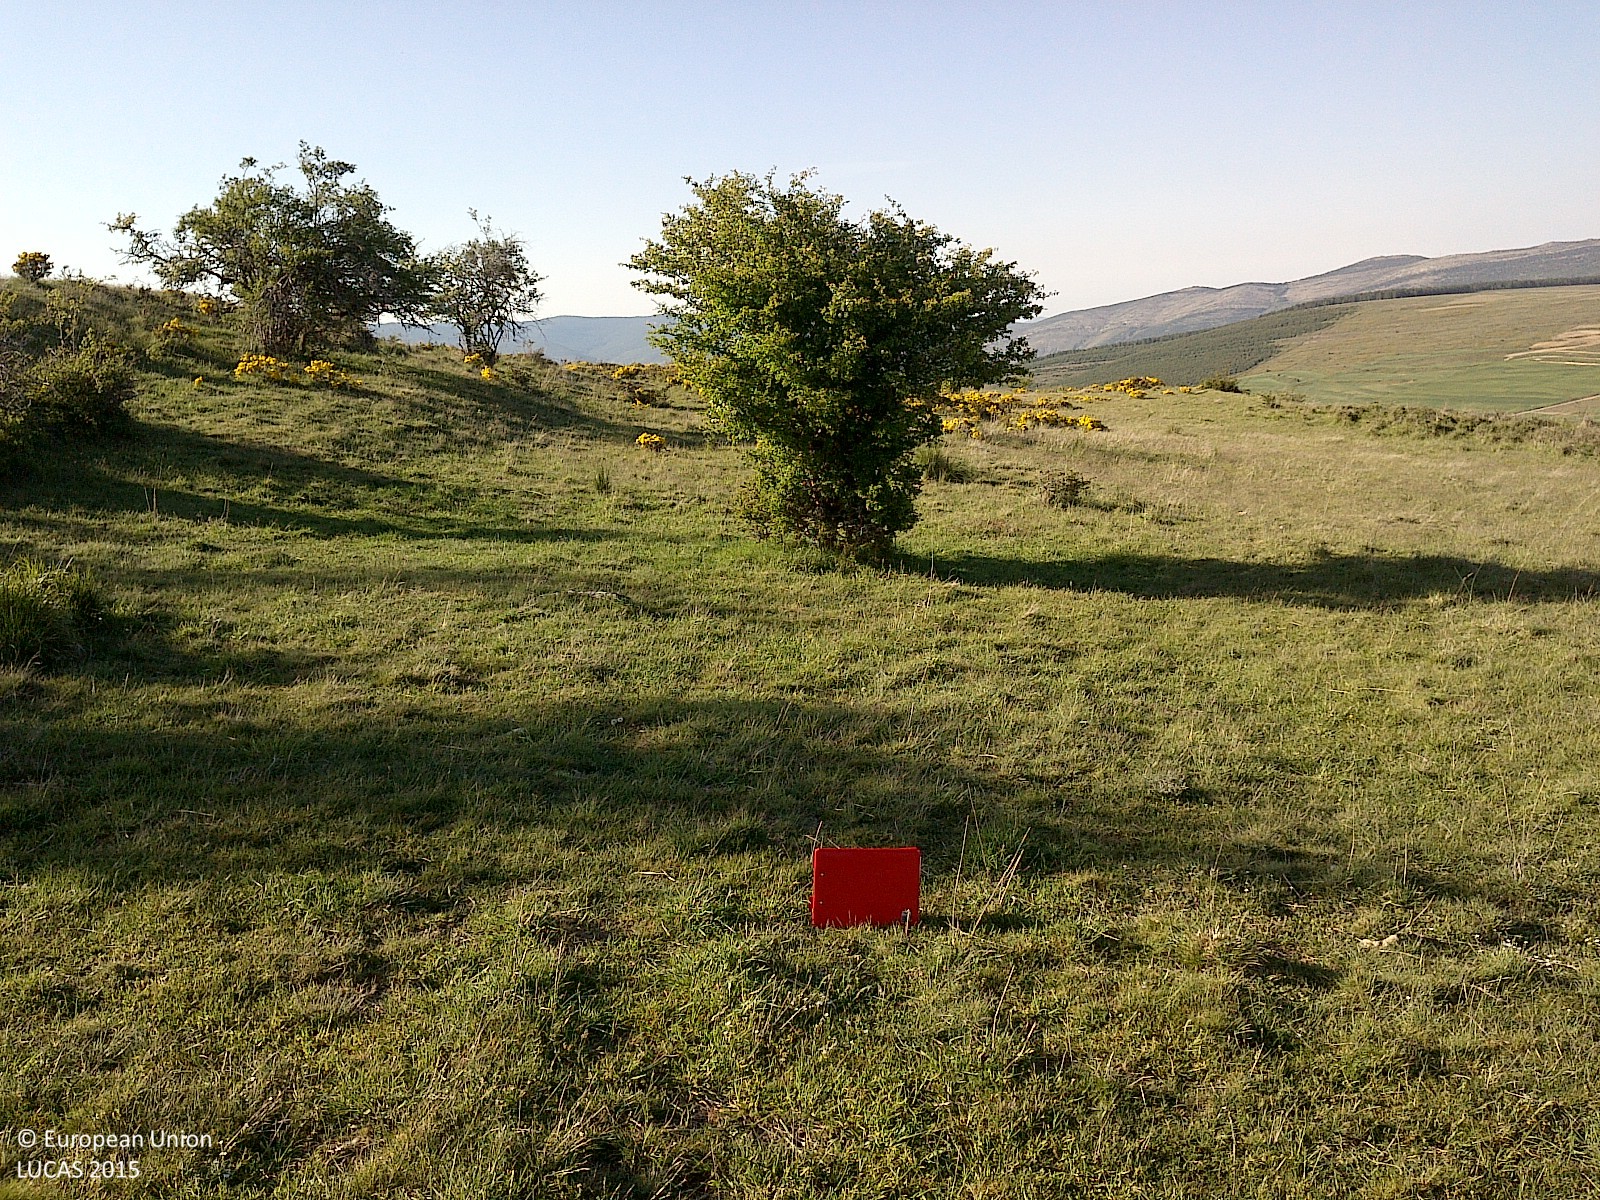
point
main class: Grassland
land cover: Grassland with sparse tree/shrub cover
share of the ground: 50 - 75 %
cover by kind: herbaceous plants 65 %, consolidated bare surface 25 %, broadleaved forest trees 5 %, shrubs 5 %
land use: Agriculture (excluding fallow land and kitchen gardens)
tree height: < 5 m
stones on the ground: < 10 %
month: May
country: ES
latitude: 42.0233
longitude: -2.3459
